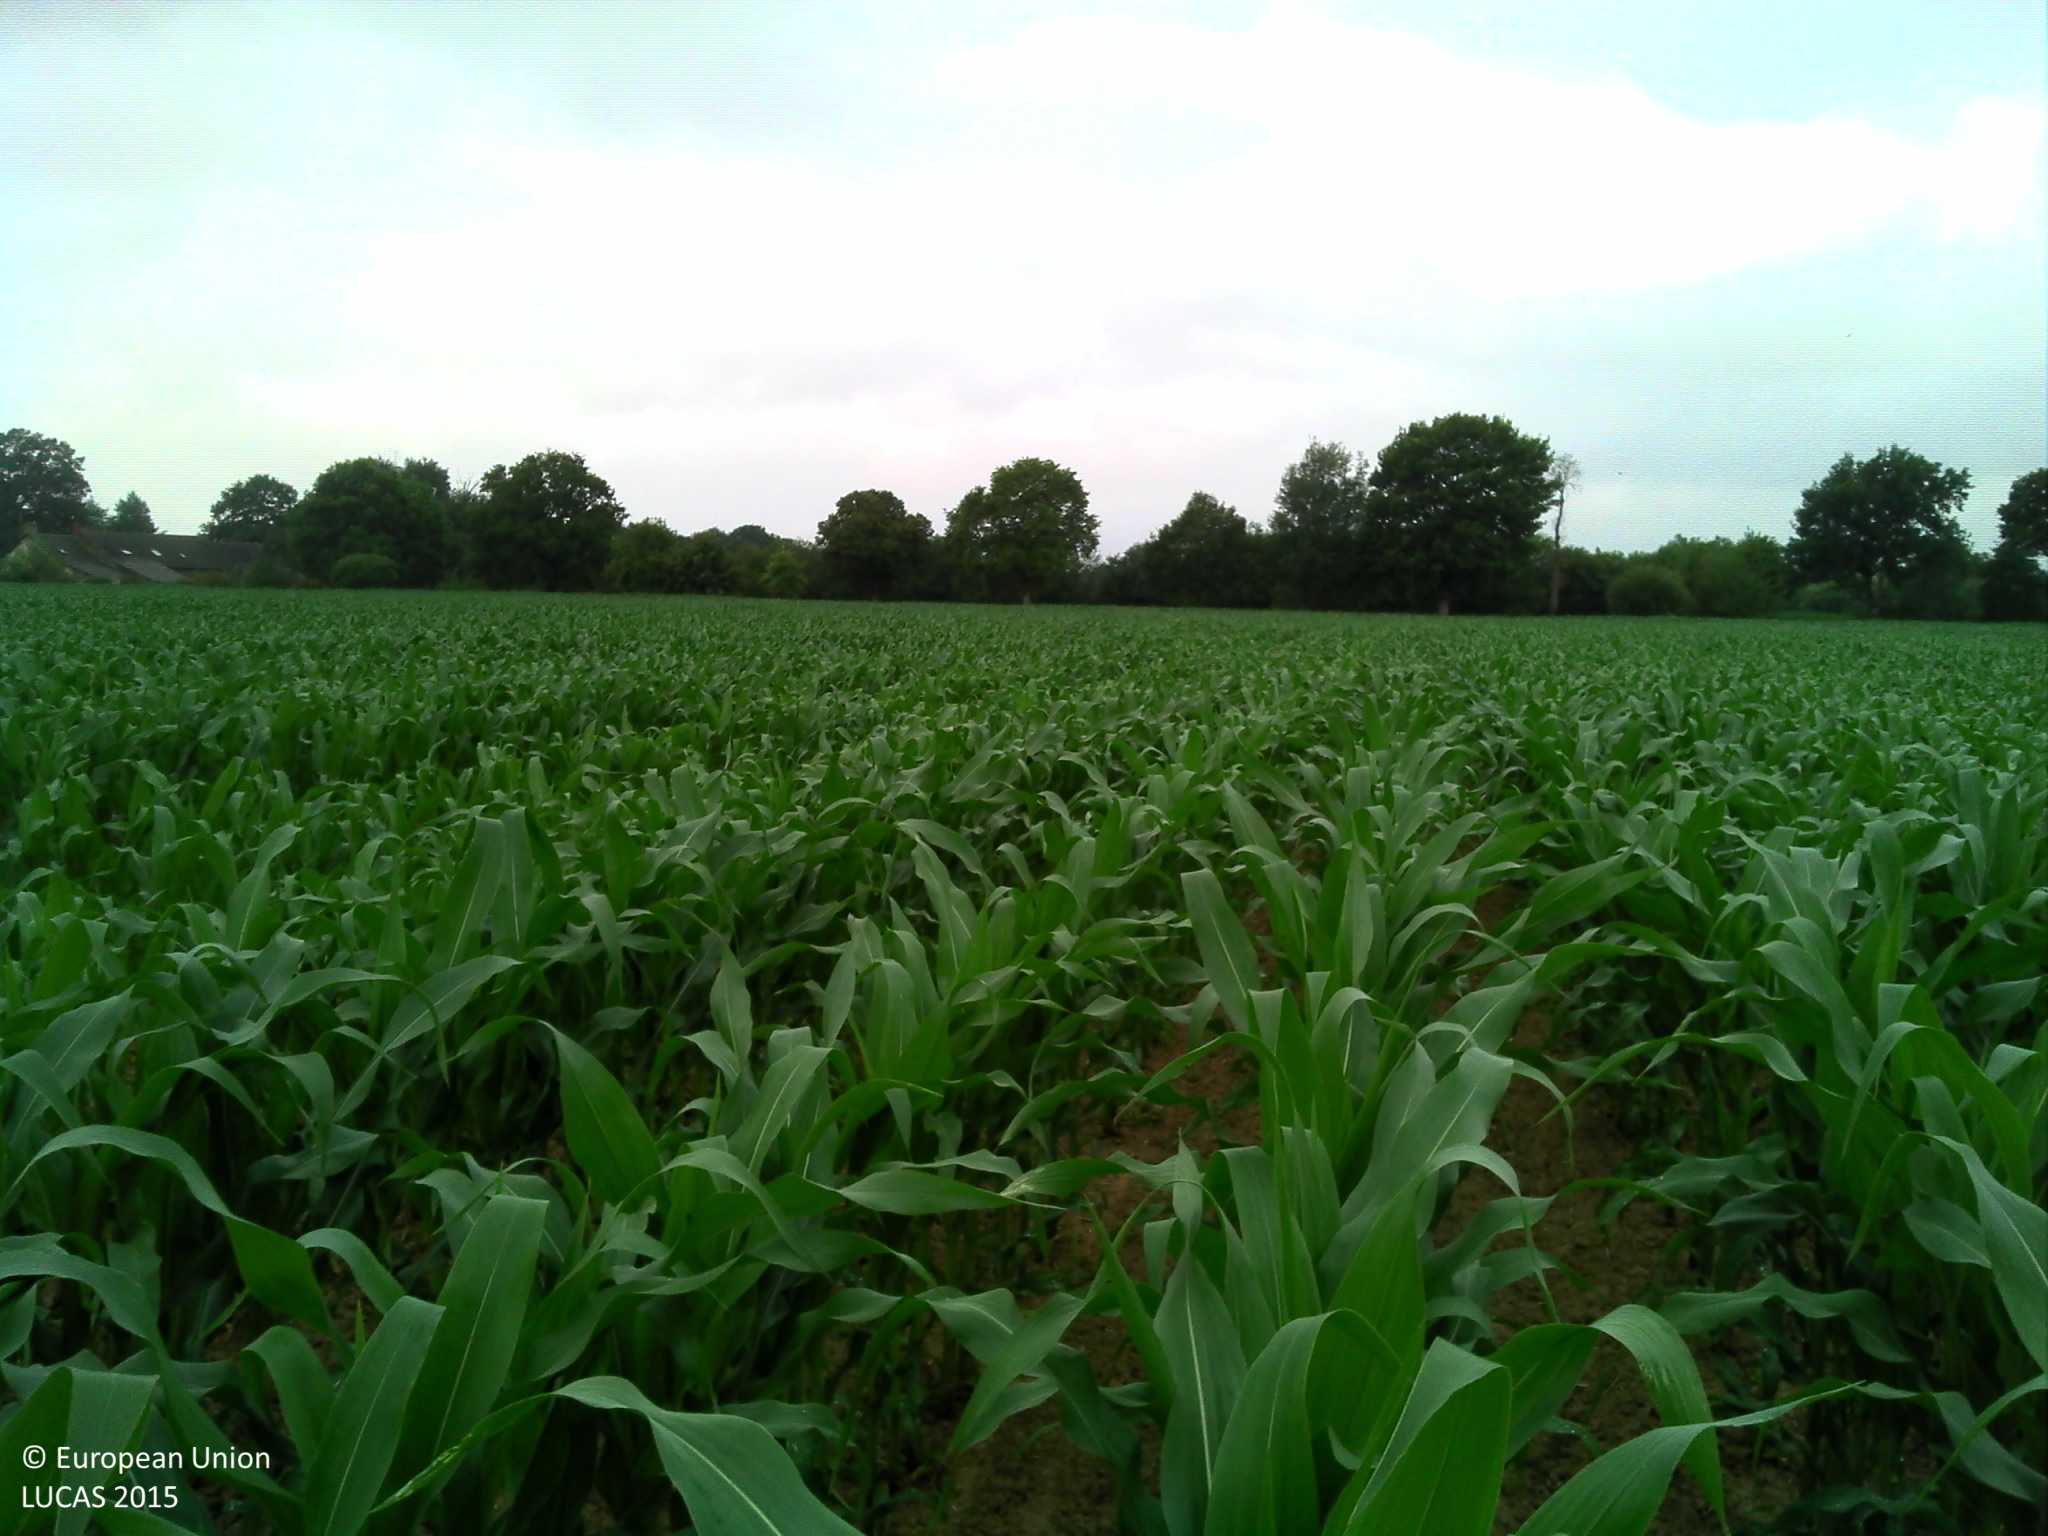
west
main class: Cropland
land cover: Maize
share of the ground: > 75 %
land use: Agriculture (excluding fallow land and kitchen gardens)
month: July
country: FR
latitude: 47.8875
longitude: -1.3704
